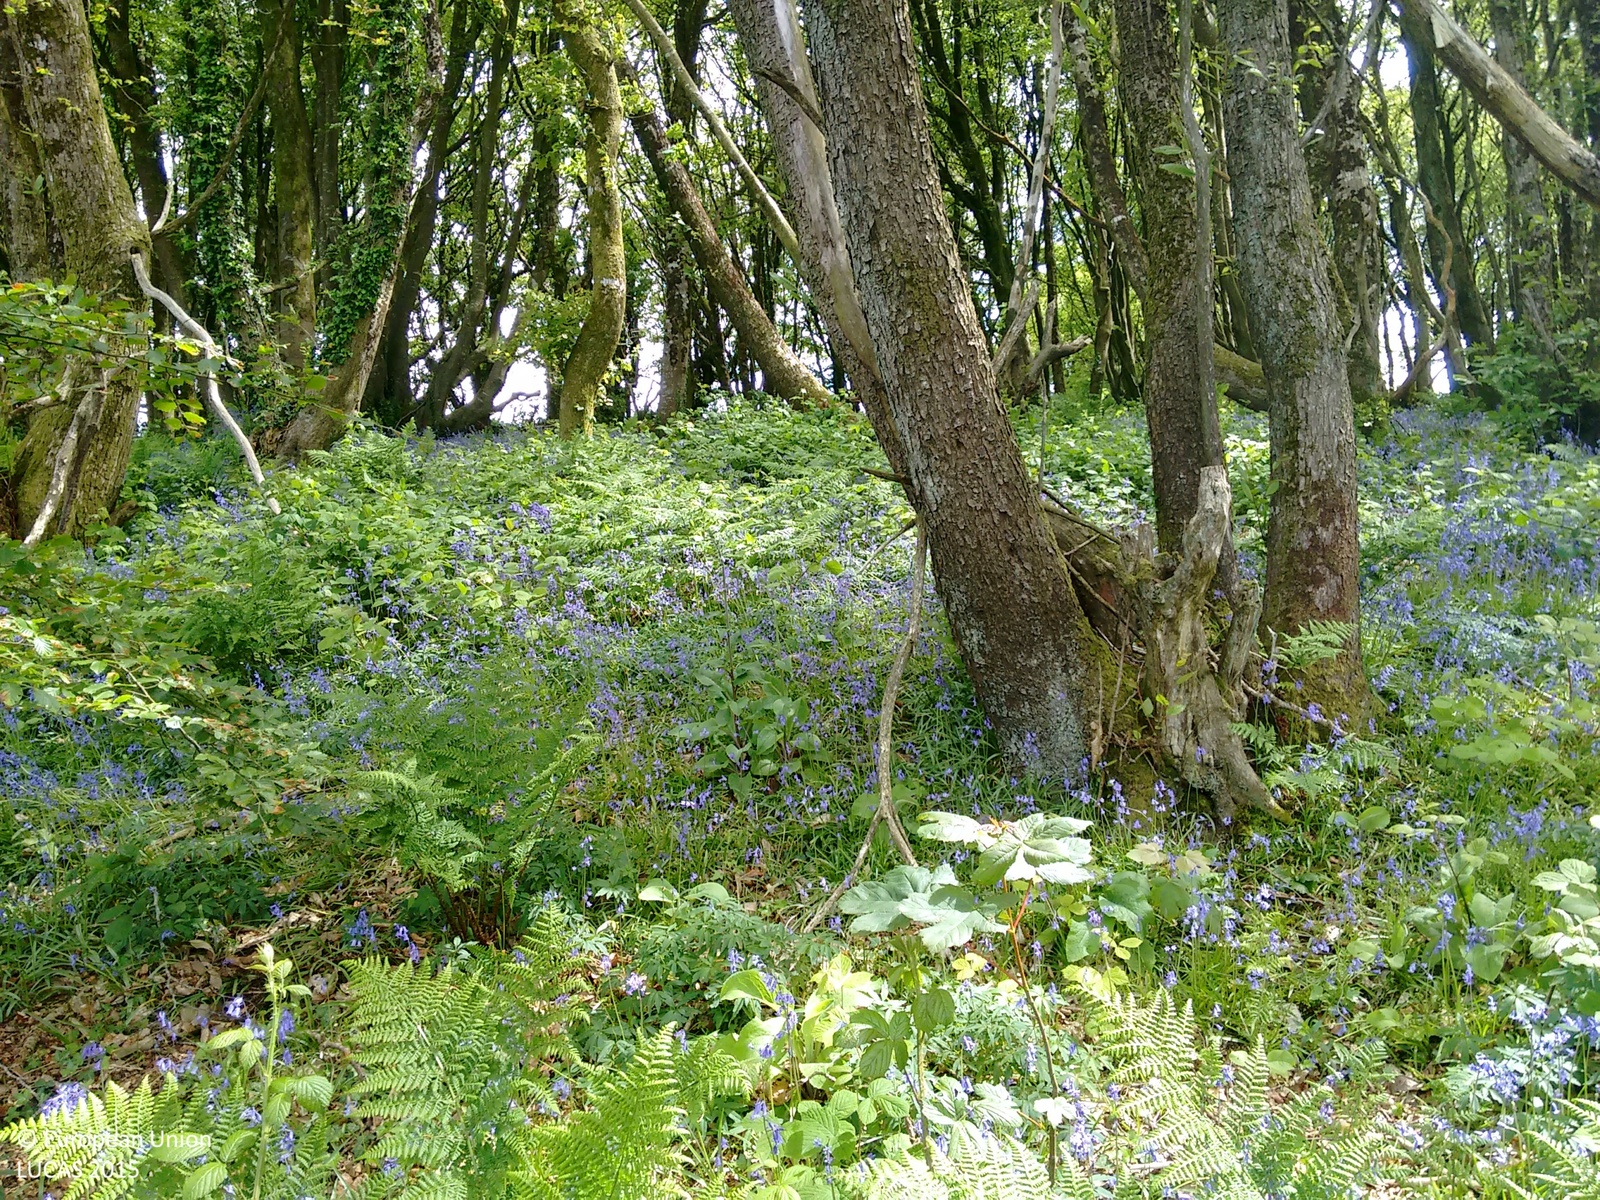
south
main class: Woodland
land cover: Broadleaved woodland
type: mesophytic deciduous forest
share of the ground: > 75 %
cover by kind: broadleaved forest trees 90 %, shrubs 10 %
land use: Semi-natural and natural areas not in use
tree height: > 5 m
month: June
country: IE
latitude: 51.8920
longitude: -8.0959
